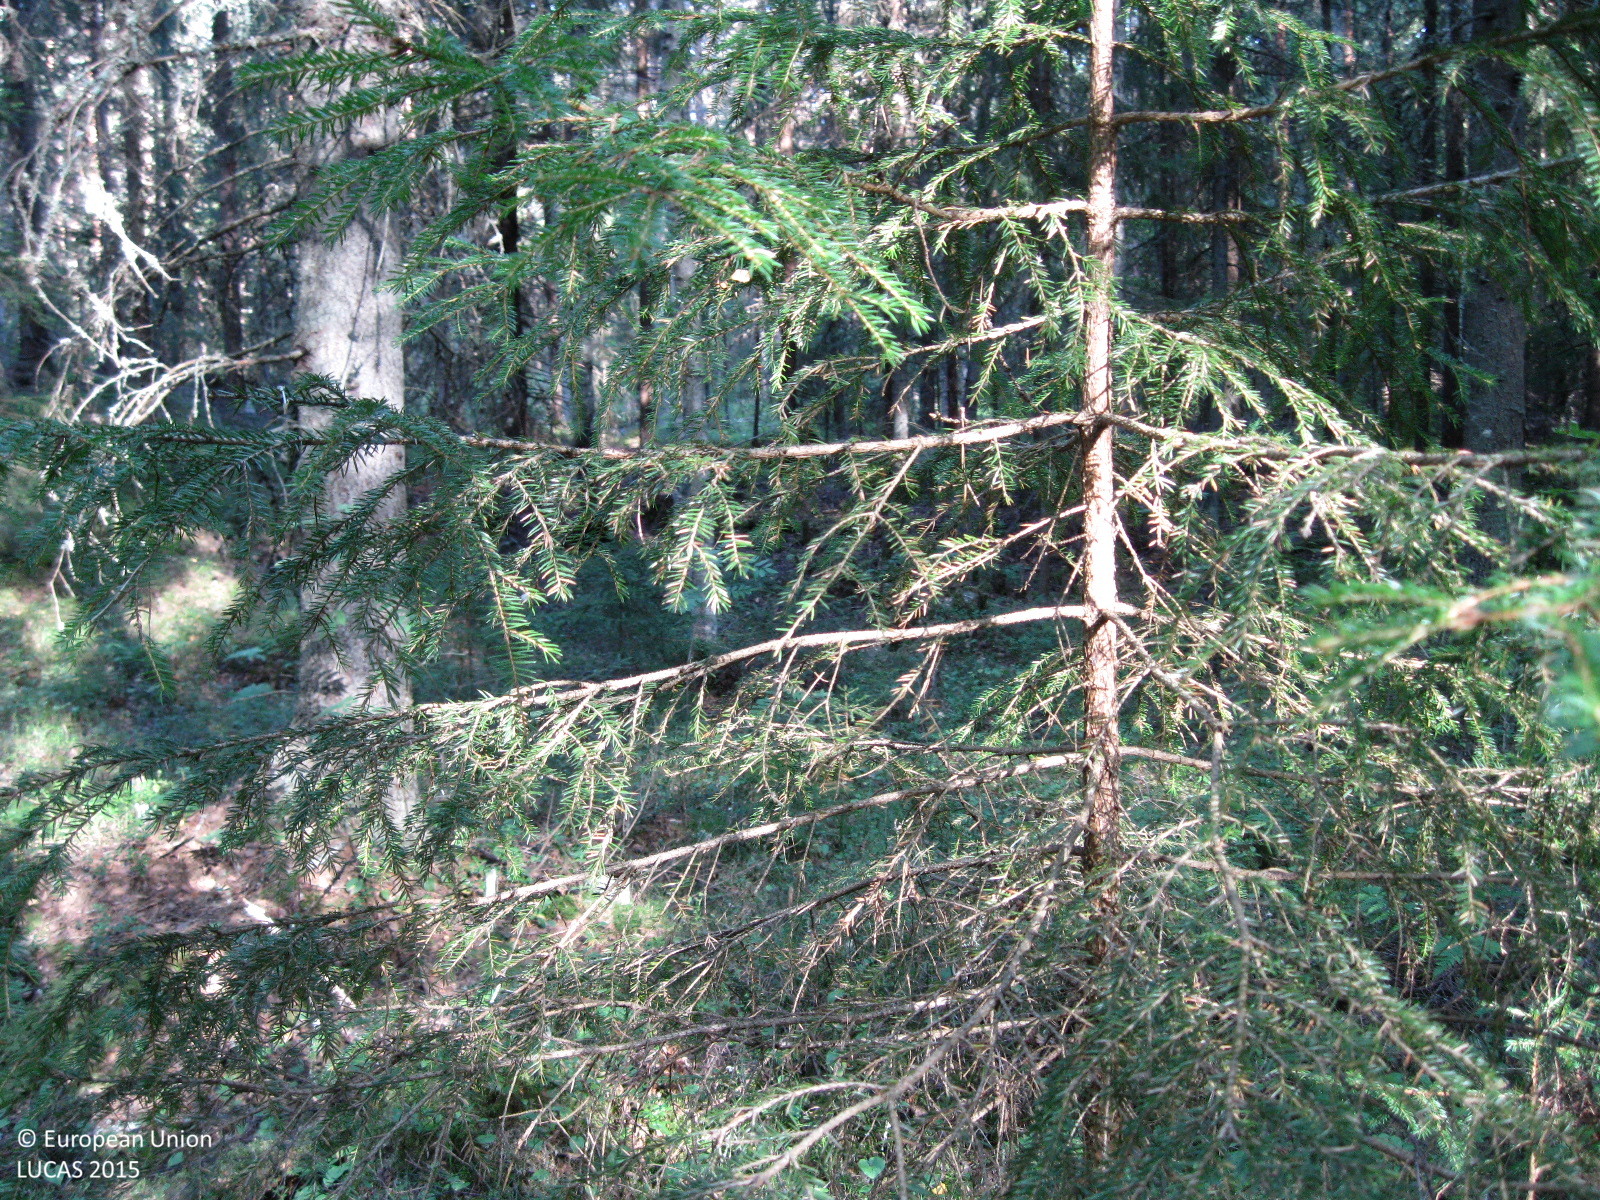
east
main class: Woodland
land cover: Spruce dominated mixed woodland
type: boreal forest
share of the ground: > 75 %
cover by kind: coniferous forest trees 65 %, broadleaved forest trees 25 %, herbaceous plants 10 %
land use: Forestry
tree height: > 5 m
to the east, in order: Spruce dominated mixed woodland; Pine dominated mixed woodland; Other mixed woodland; Grassland with sparse tree/shrub cover; Spruce dominated coniferous woodland
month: August
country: FI
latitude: 61.2689
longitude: 25.3173
